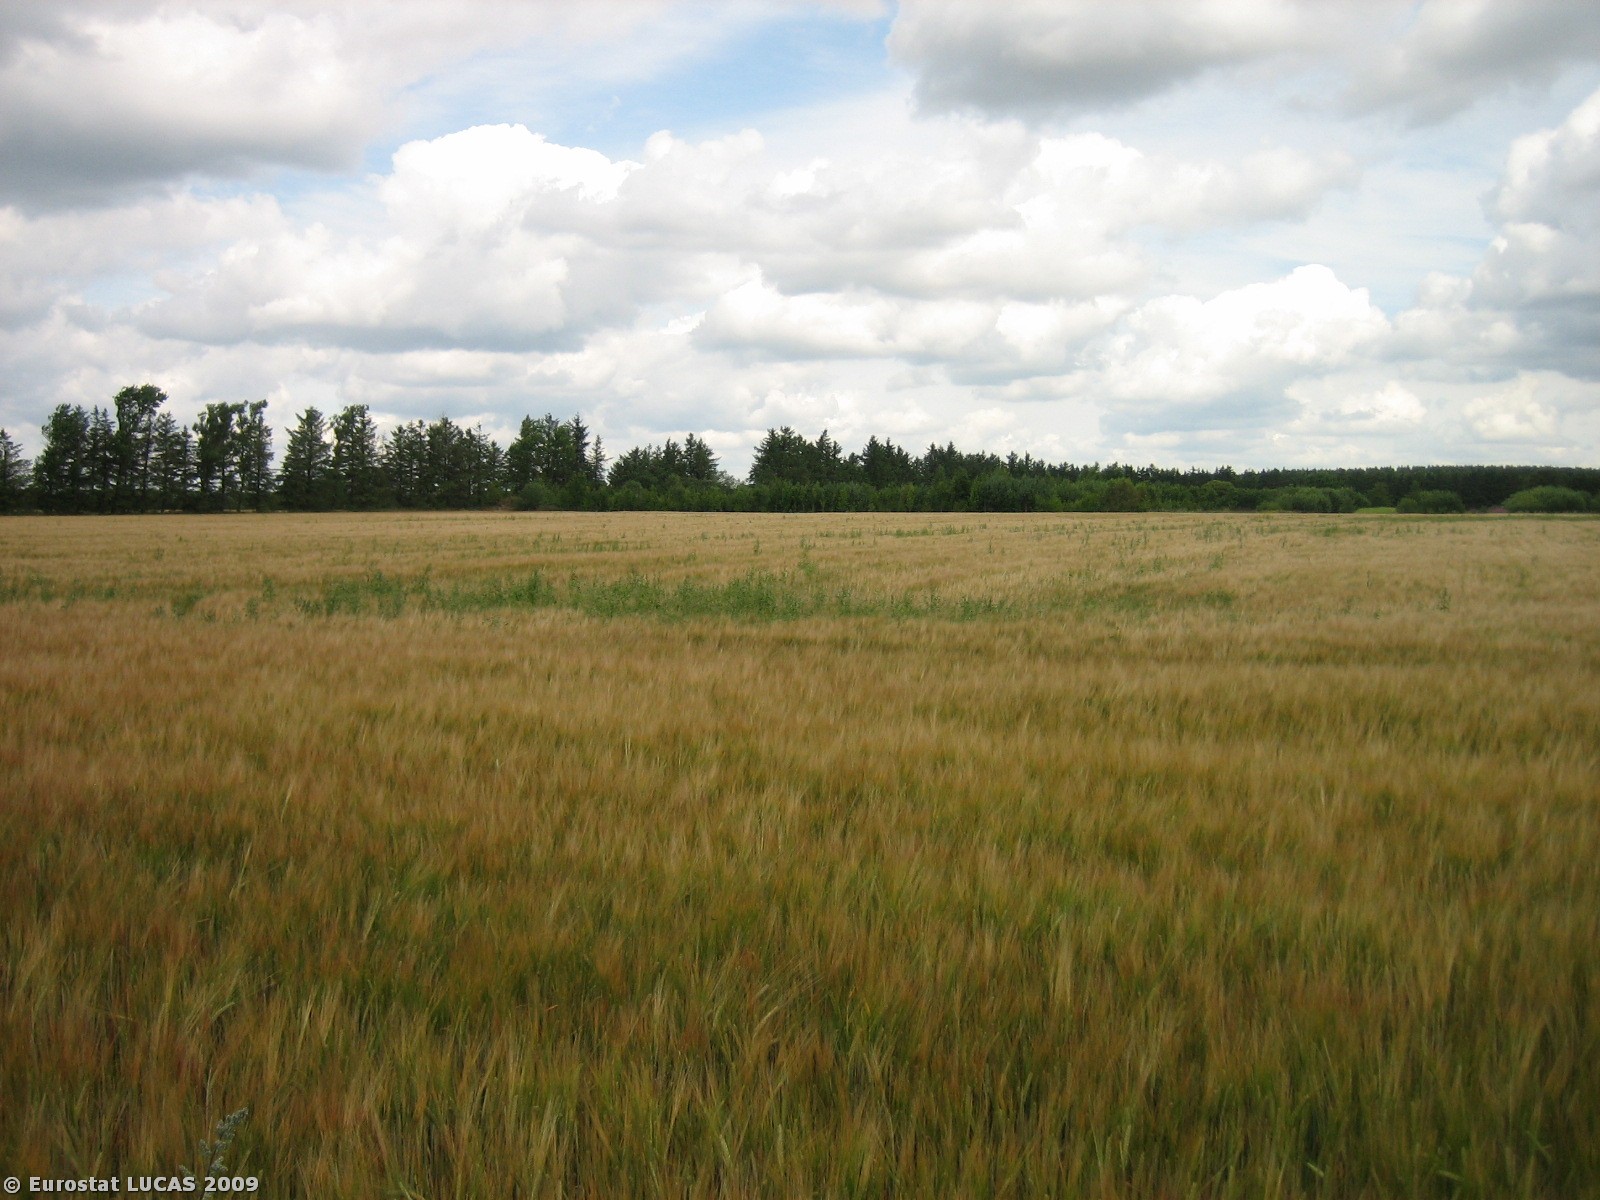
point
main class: Cropland
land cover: Barley
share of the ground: > 75 %
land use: Agriculture (excluding fallow land and kitchen gardens)
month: July
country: DK
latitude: 55.7883
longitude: 8.9963
